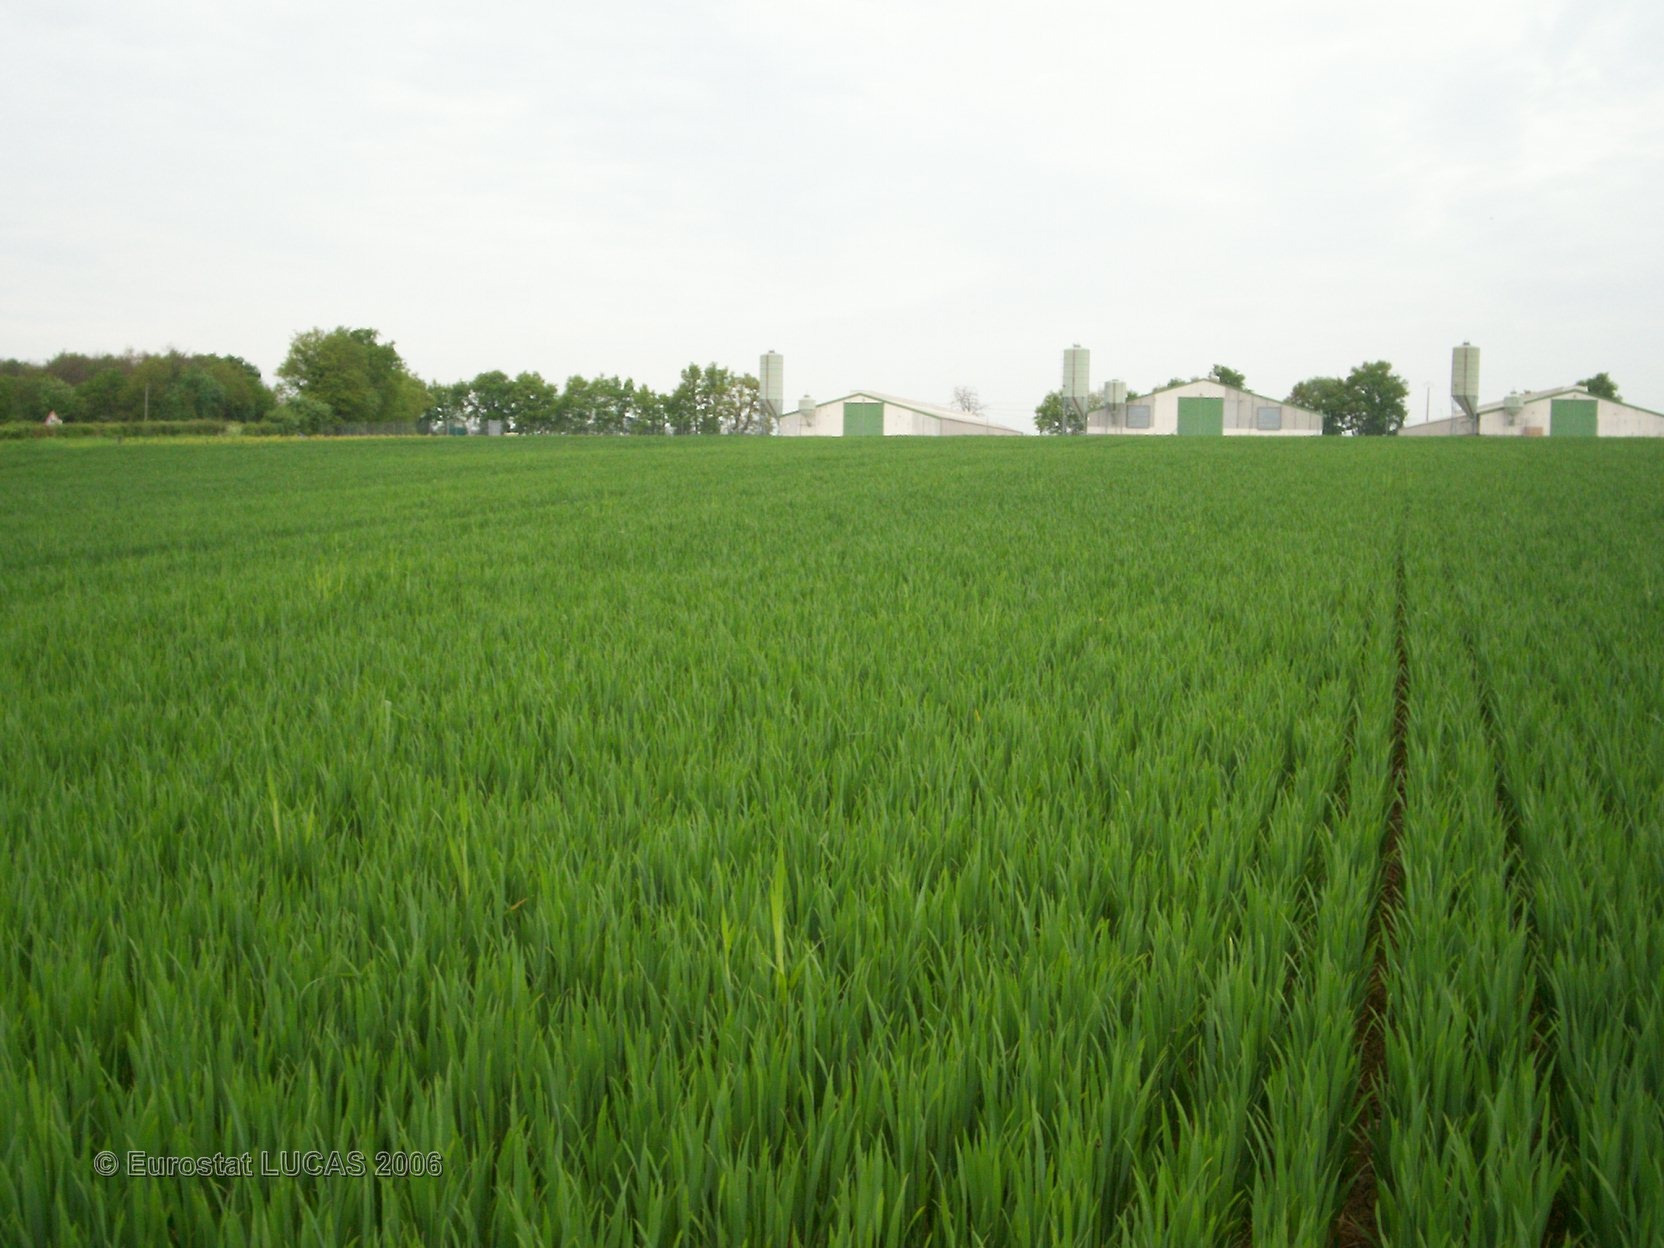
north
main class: Cropland
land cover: Common wheat
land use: Agriculture (excluding fallow land and kitchen gardens)
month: May
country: FR
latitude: 46.7586
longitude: -1.0444
